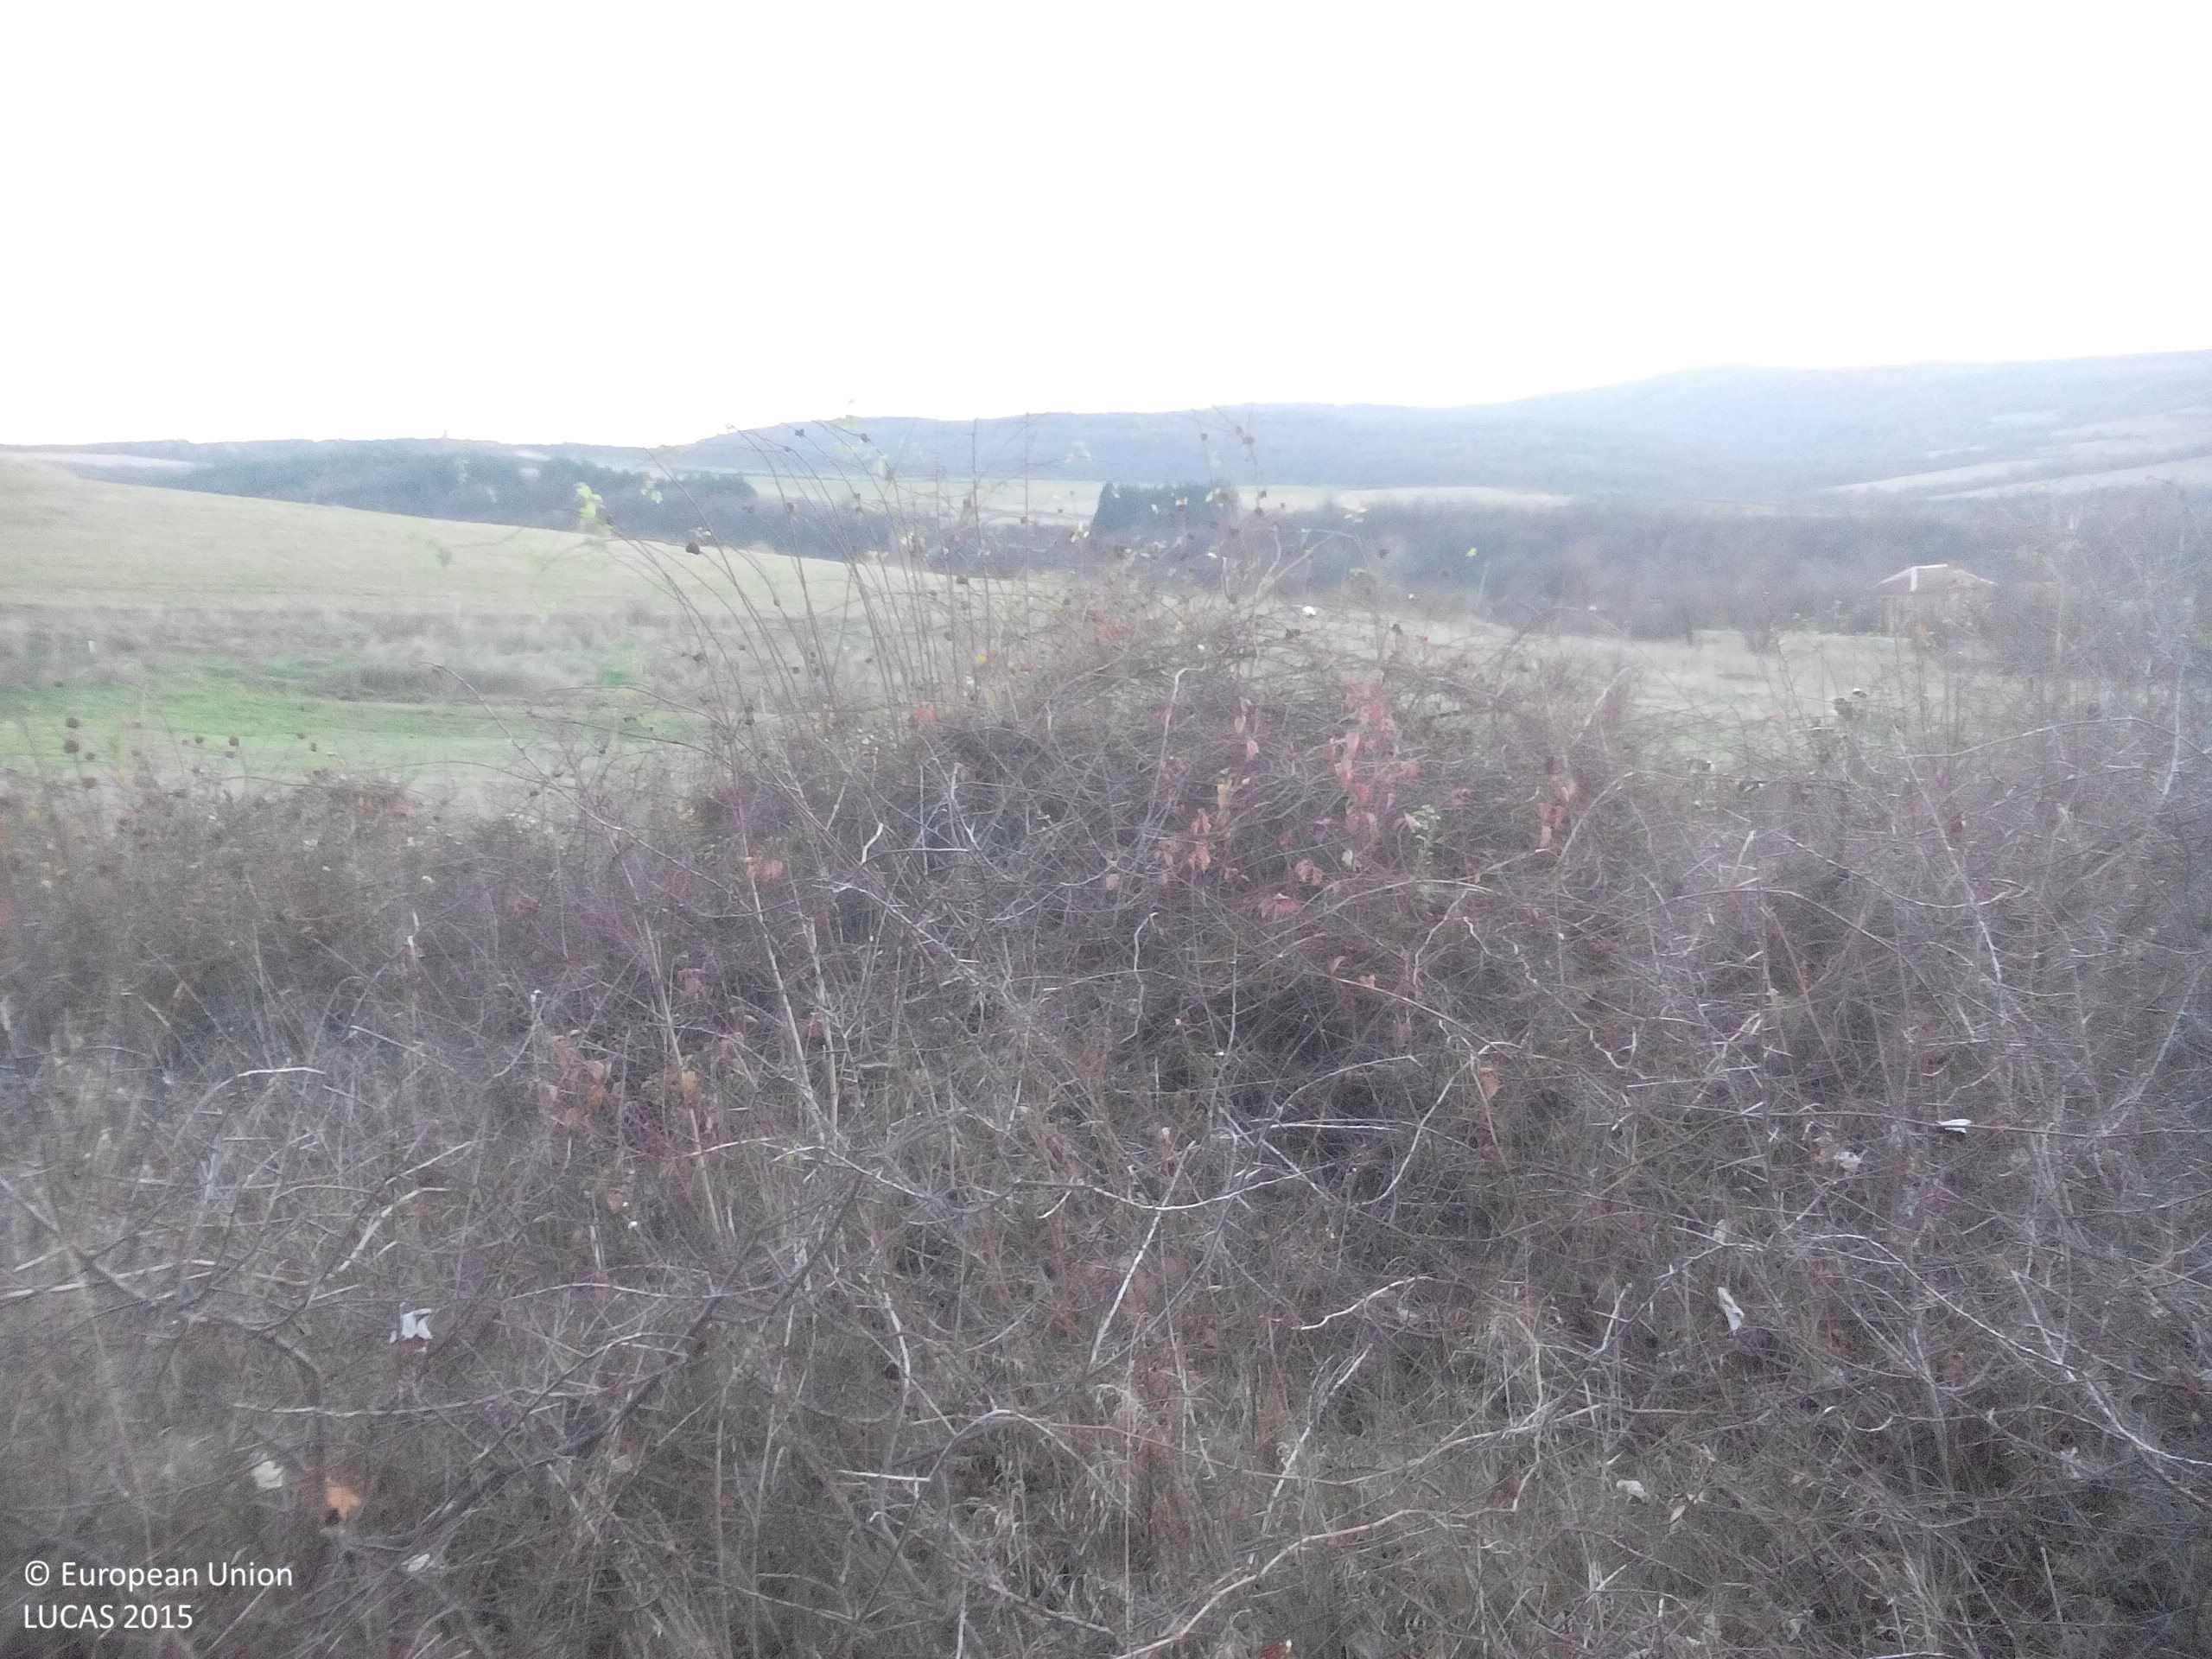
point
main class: Shrubland
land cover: Shrubland without tree cover
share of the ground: > 75 %
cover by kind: shrubs 90 %, herbaceous plants 10 %
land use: Abandoned areas
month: November
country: BG
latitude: 43.1130
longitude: 23.7973
